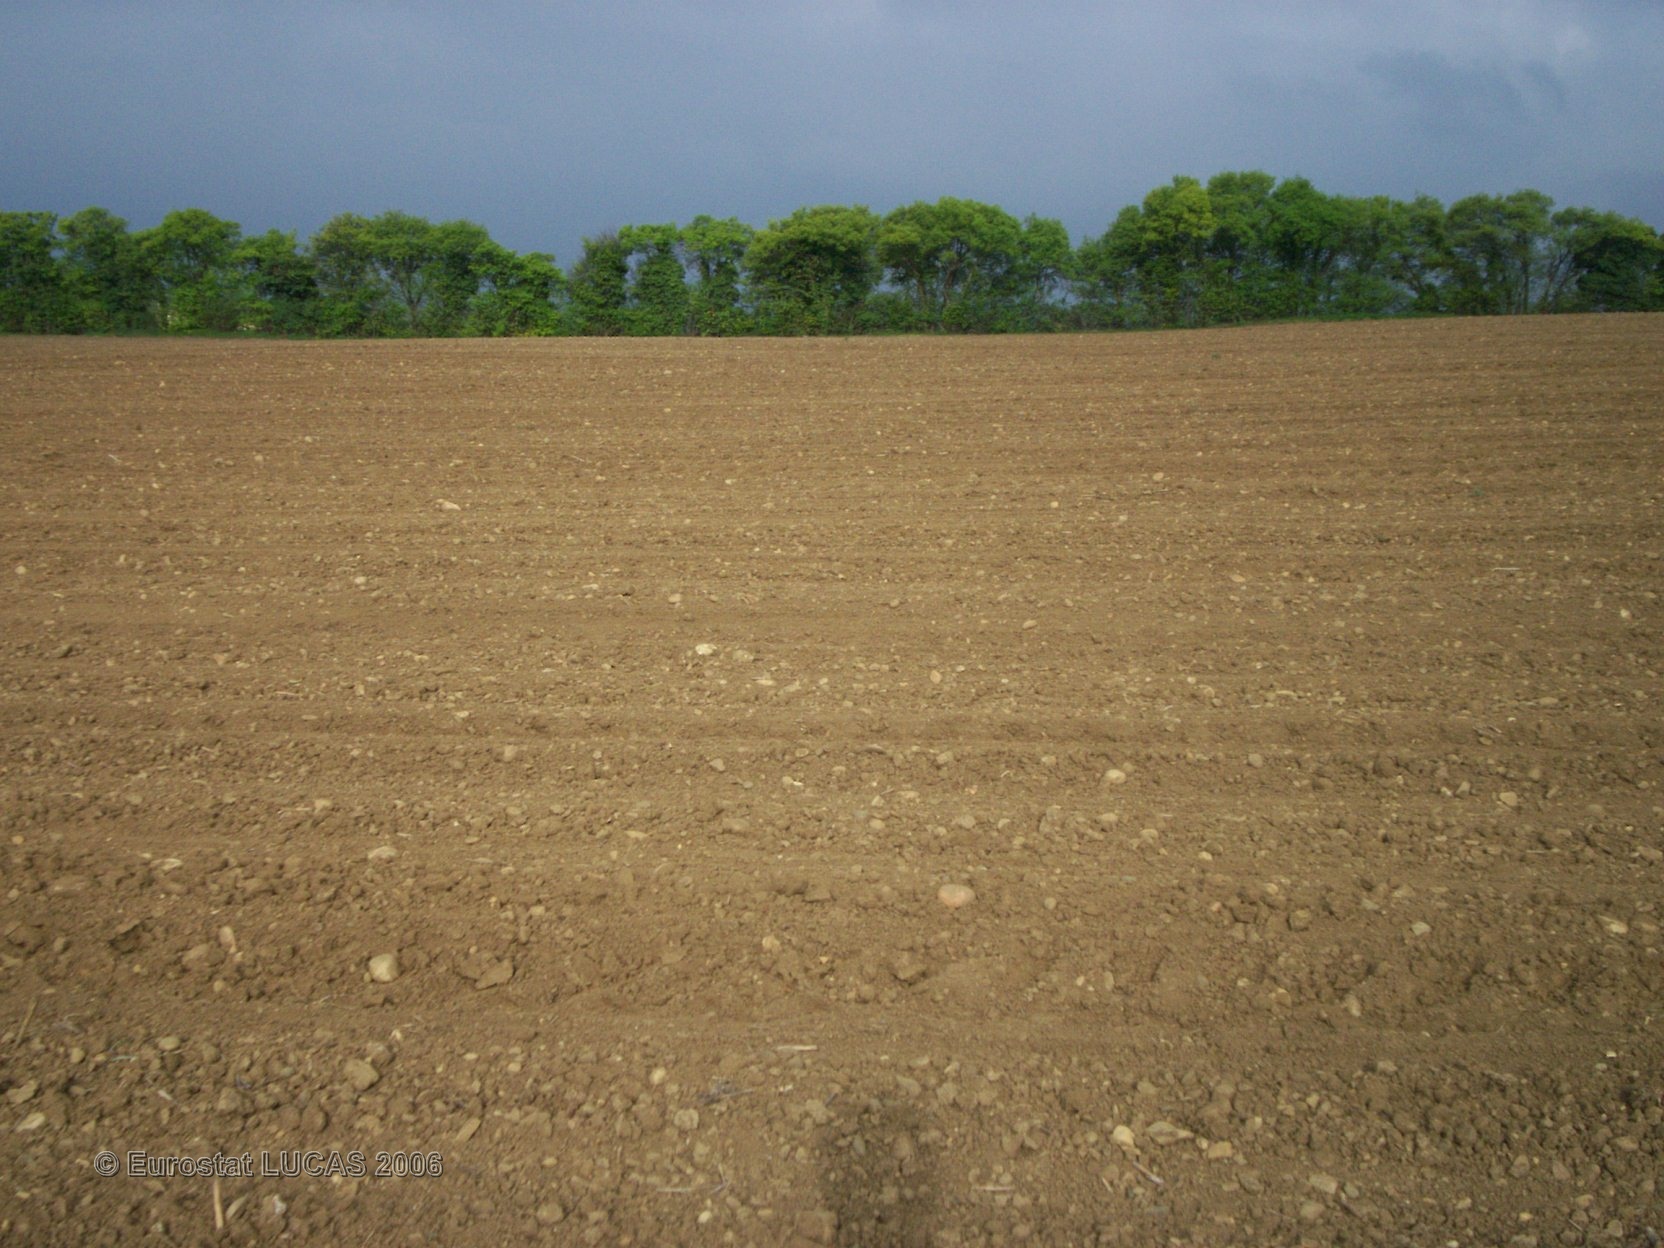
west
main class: Cropland
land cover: Common wheat
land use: Agriculture (excluding fallow land and kitchen gardens)
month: April
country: FR
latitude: 45.3432
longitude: 4.8614
